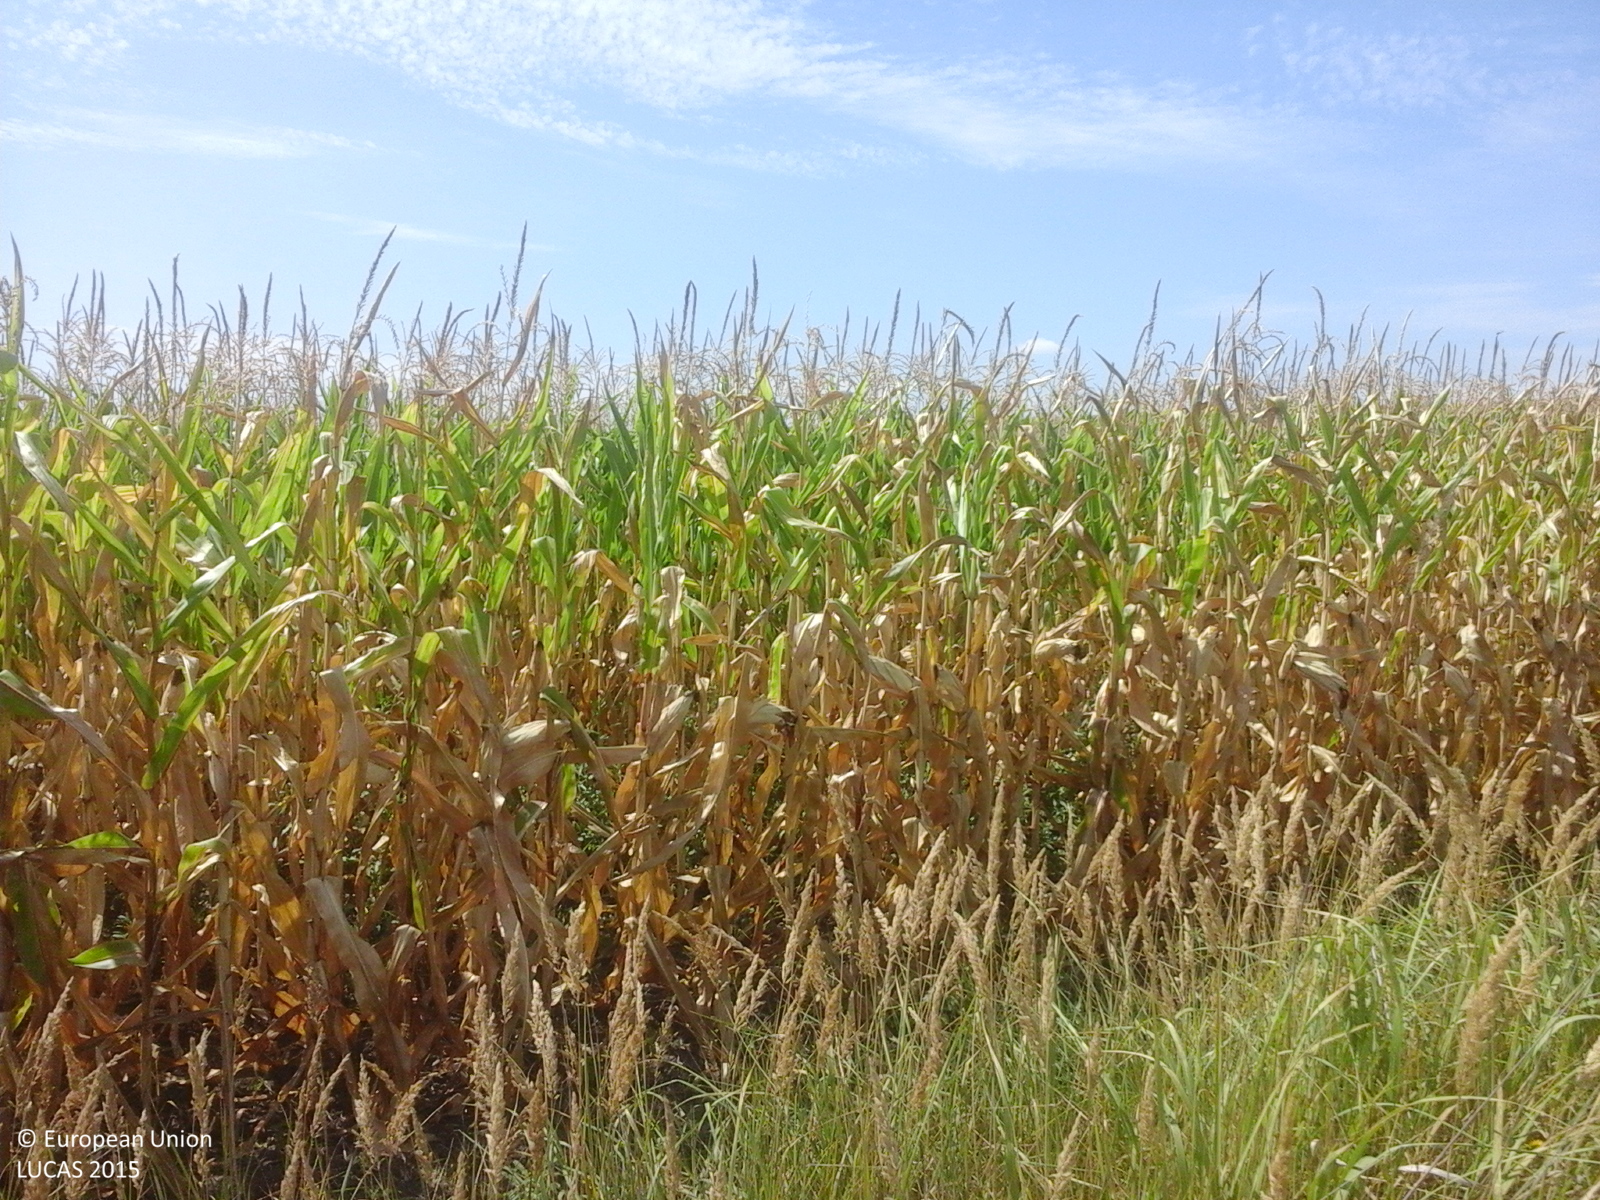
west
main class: Grassland
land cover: Grassland with sparse tree/shrub cover
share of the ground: > 75 %
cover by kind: herbaceous plants 85 %, shrubs 10 %, broadleaved forest trees 5 %
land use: Fallow land
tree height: < 5 m
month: August
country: RO
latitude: 45.3572
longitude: 21.4043
